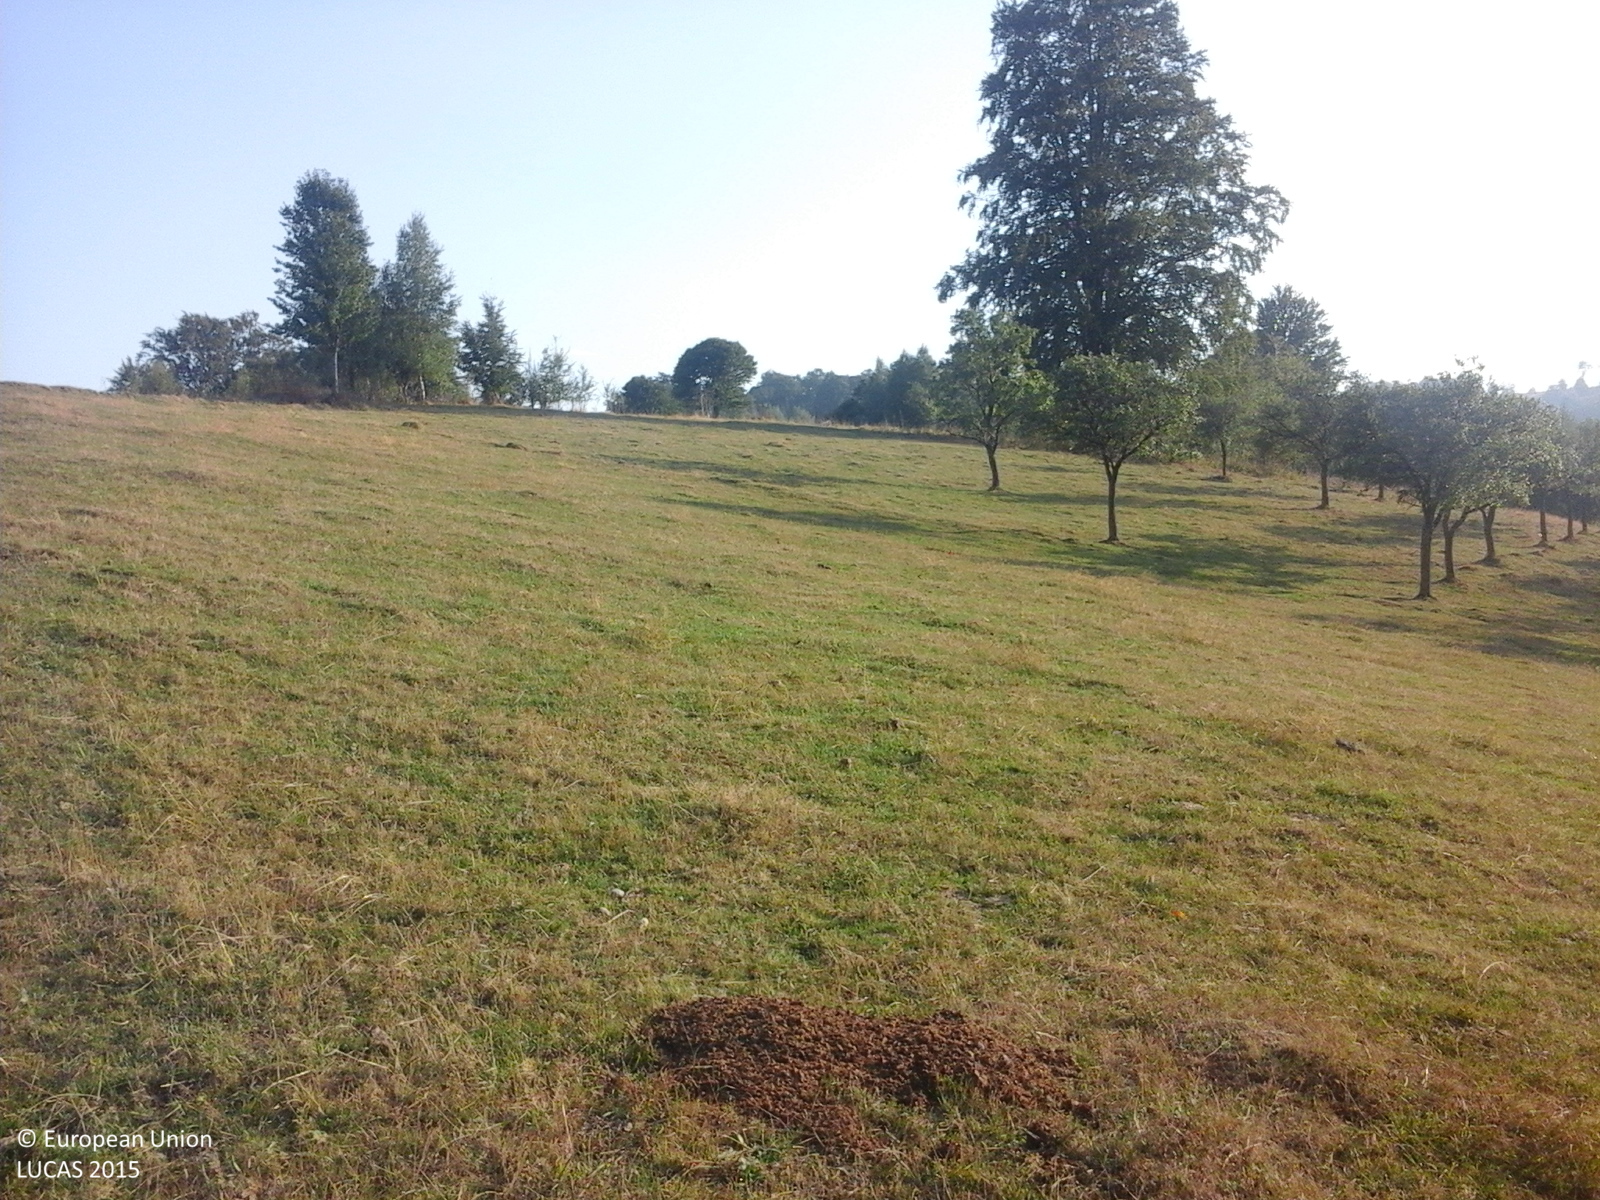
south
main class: Grassland
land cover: Grassland without tree/shrub cover
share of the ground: > 75 %
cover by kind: herbaceous plants 100 %
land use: Agriculture (excluding fallow land and kitchen gardens)
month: September
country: RO
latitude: 45.1596
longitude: 22.1876
